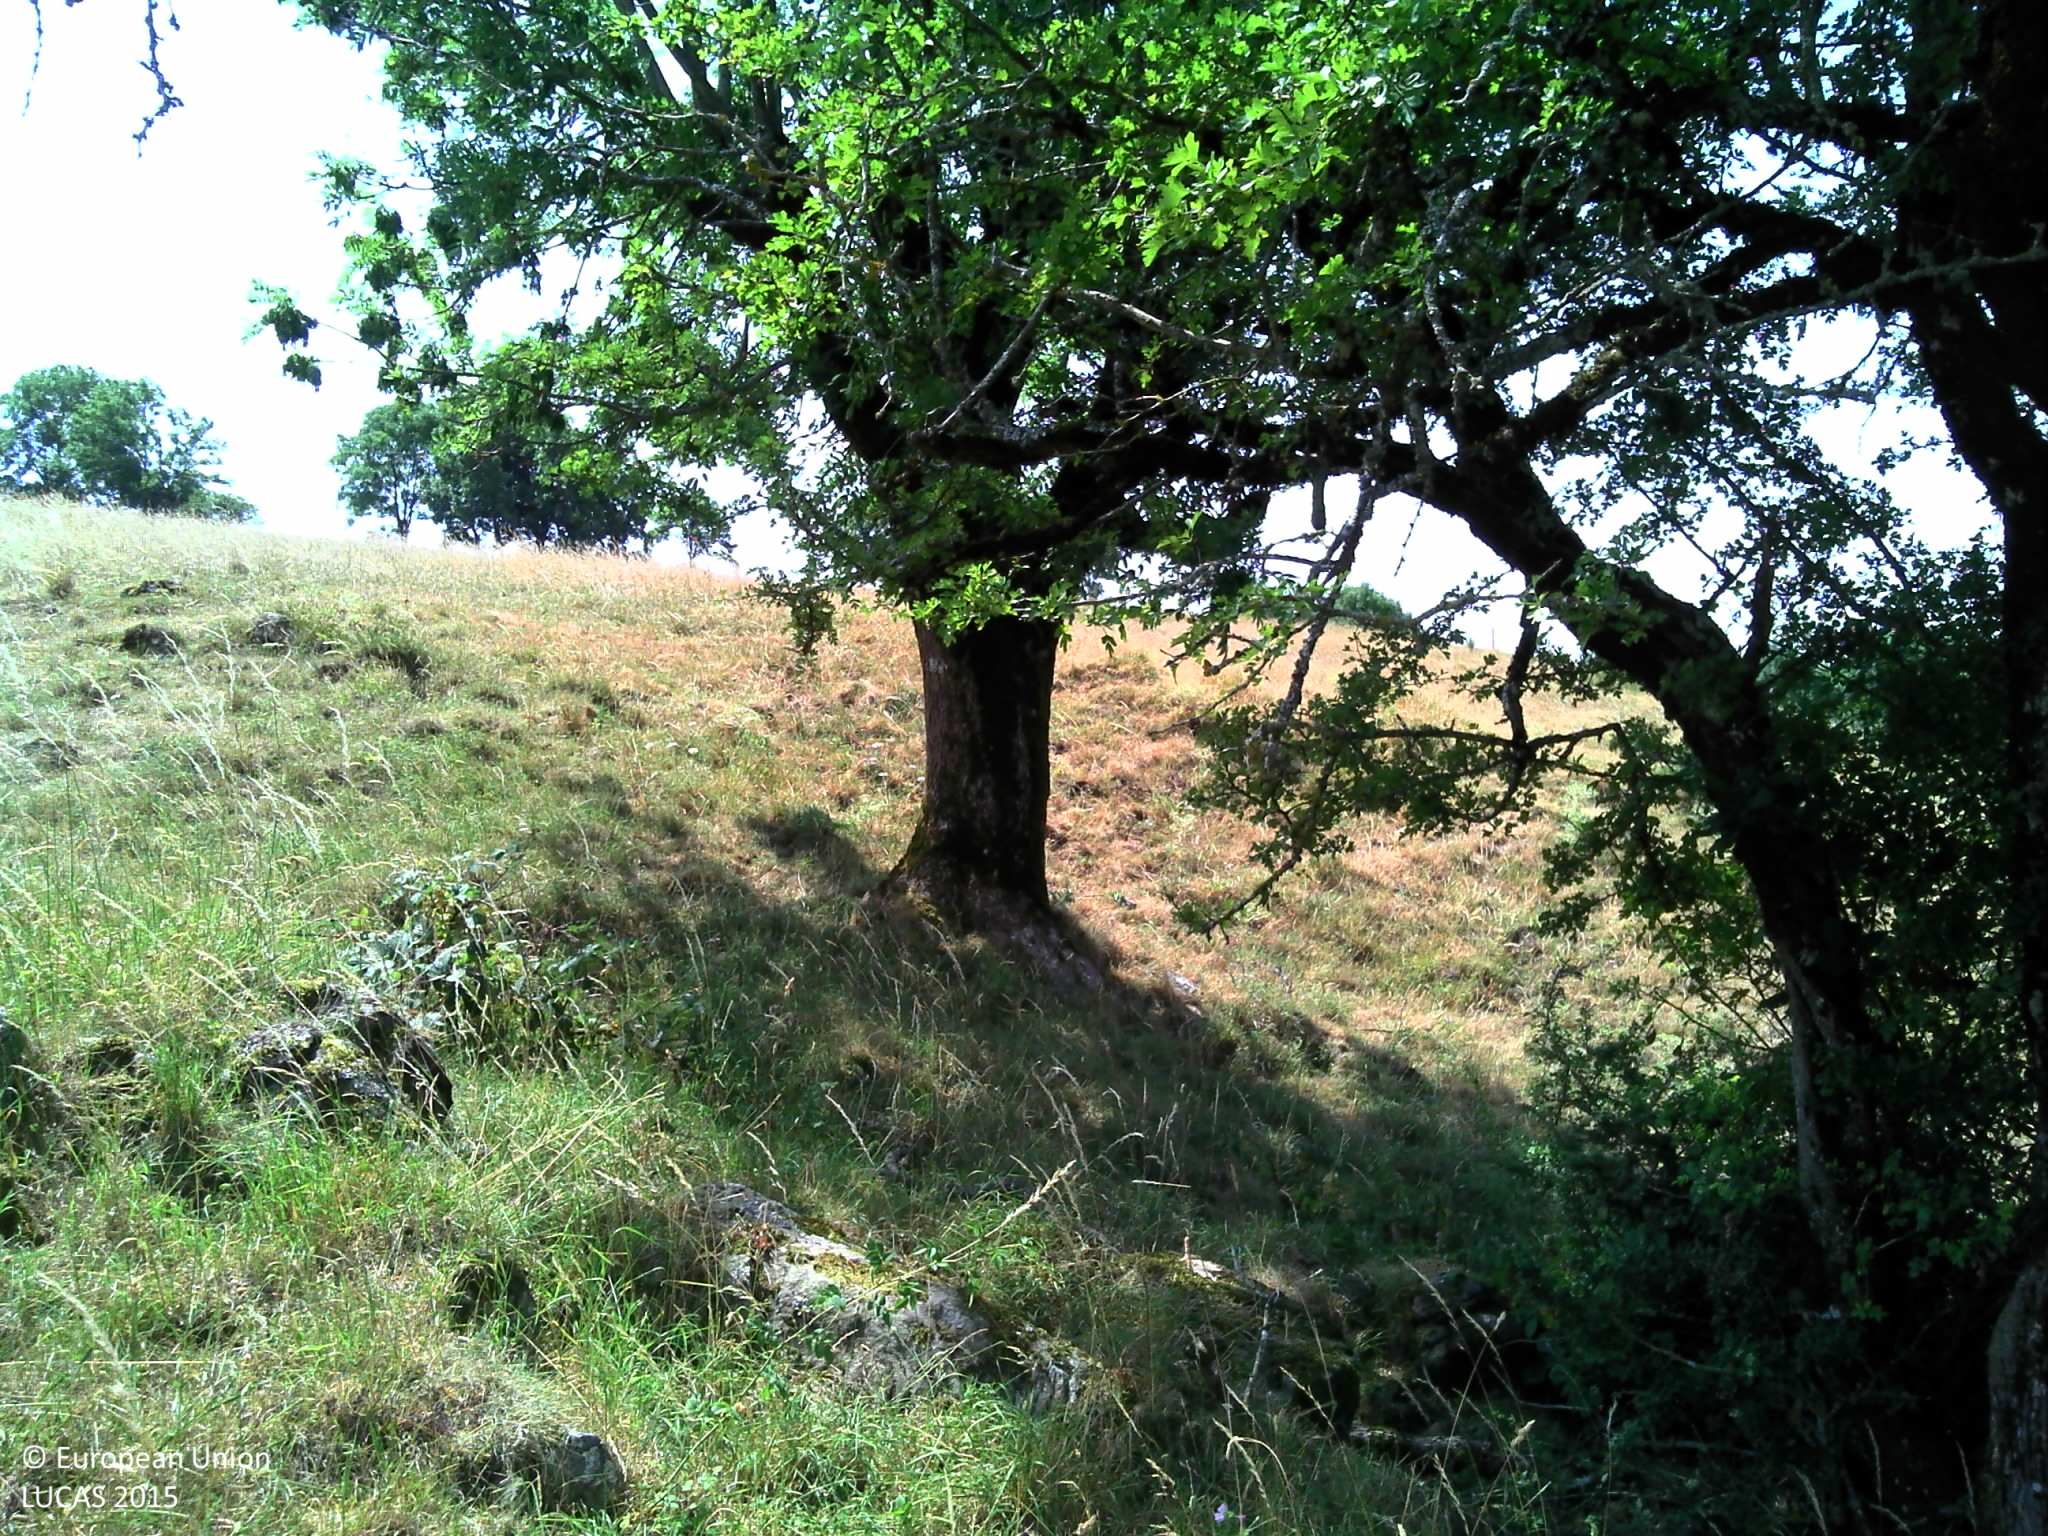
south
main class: Grassland
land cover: Grassland without tree/shrub cover
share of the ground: > 75 %
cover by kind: herbaceous plants 100 %
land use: Agriculture (excluding fallow land and kitchen gardens)
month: July
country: FR
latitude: 44.5265
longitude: 2.9449
